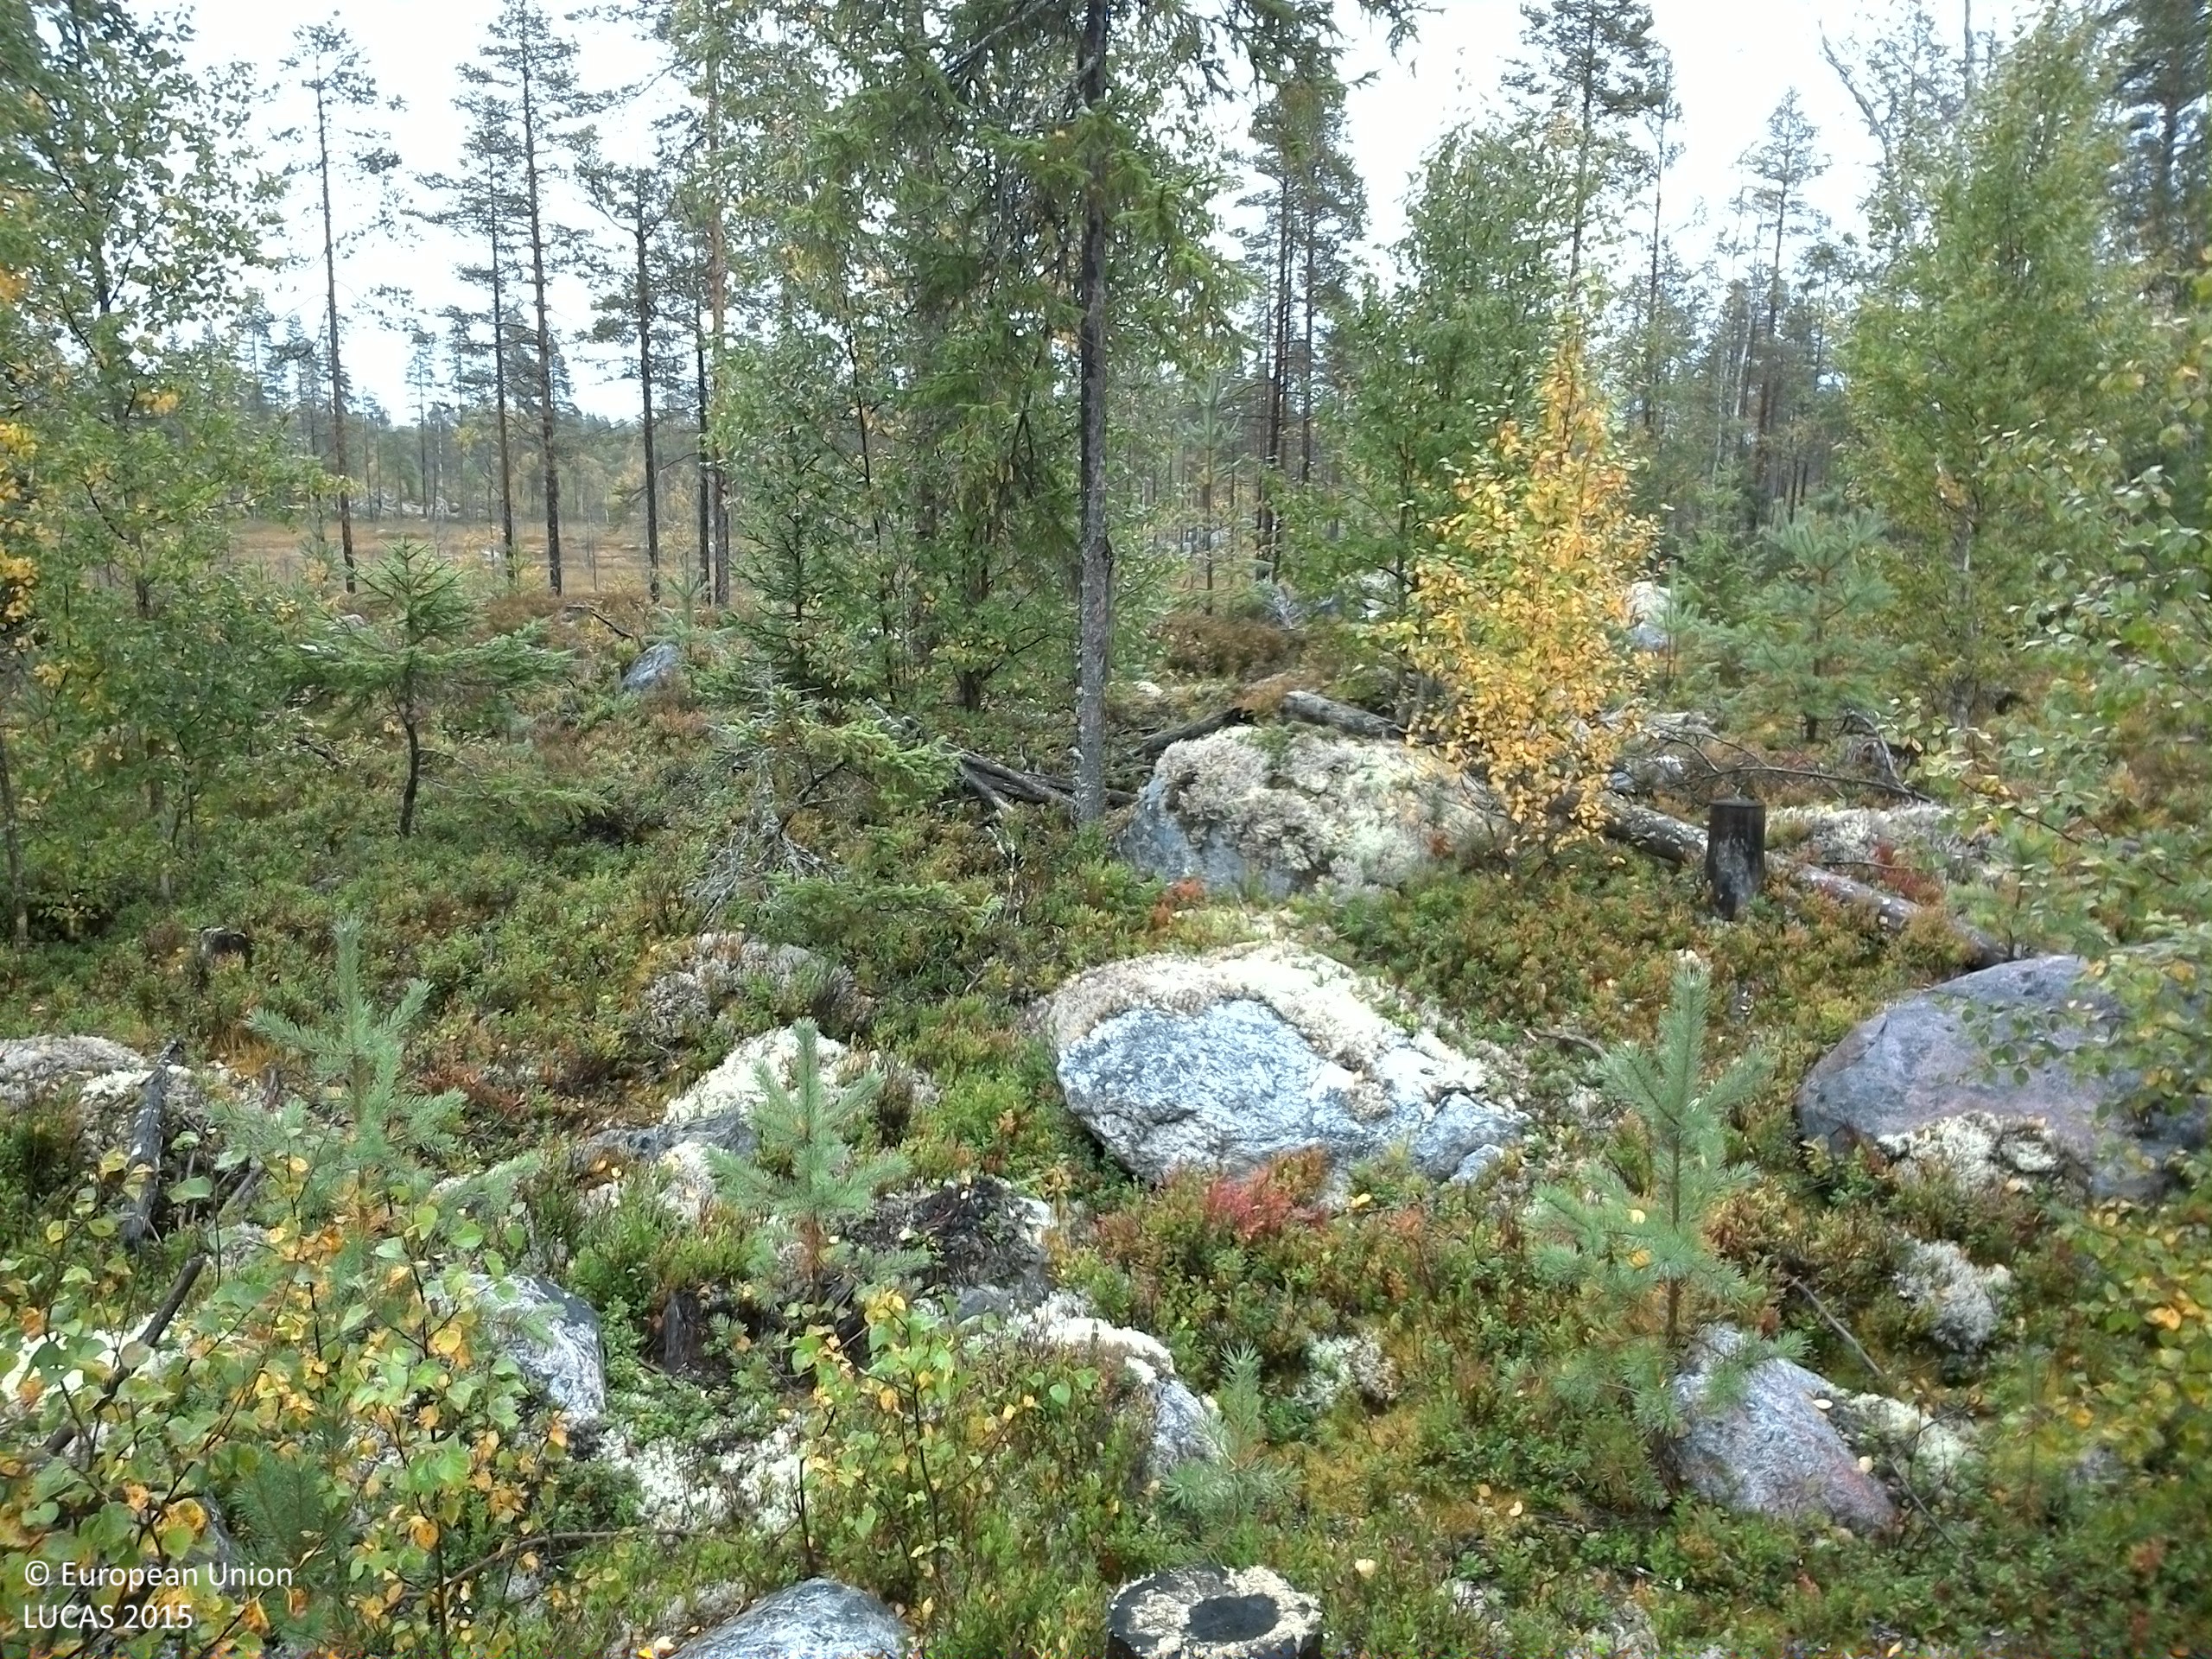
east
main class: Woodland
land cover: Other mixed woodland
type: boreal forest
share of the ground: 10 - 25 %
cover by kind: shrubs 35 %, lichens and mosses 20 %, broadleaved forest trees 15 %, consolidated bare surface 15 %, coniferous forest trees 10 %, herbaceous plants 5 %
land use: Forestry
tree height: > 5 m
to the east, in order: Other mixed woodland; Pine dominated coniferous woodland; Peatbogs; Inland fresh water bodies; Pine dominated coniferous woodland; Shrubland with sparse tree cover; Pine dominated mixed woodland; Peatbogs; Pine dominated coniferous woodland; Shrubland with sparse tree cover; Pine dominated coniferous woodland
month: September
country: SE
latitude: 61.4959
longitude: 15.1124
